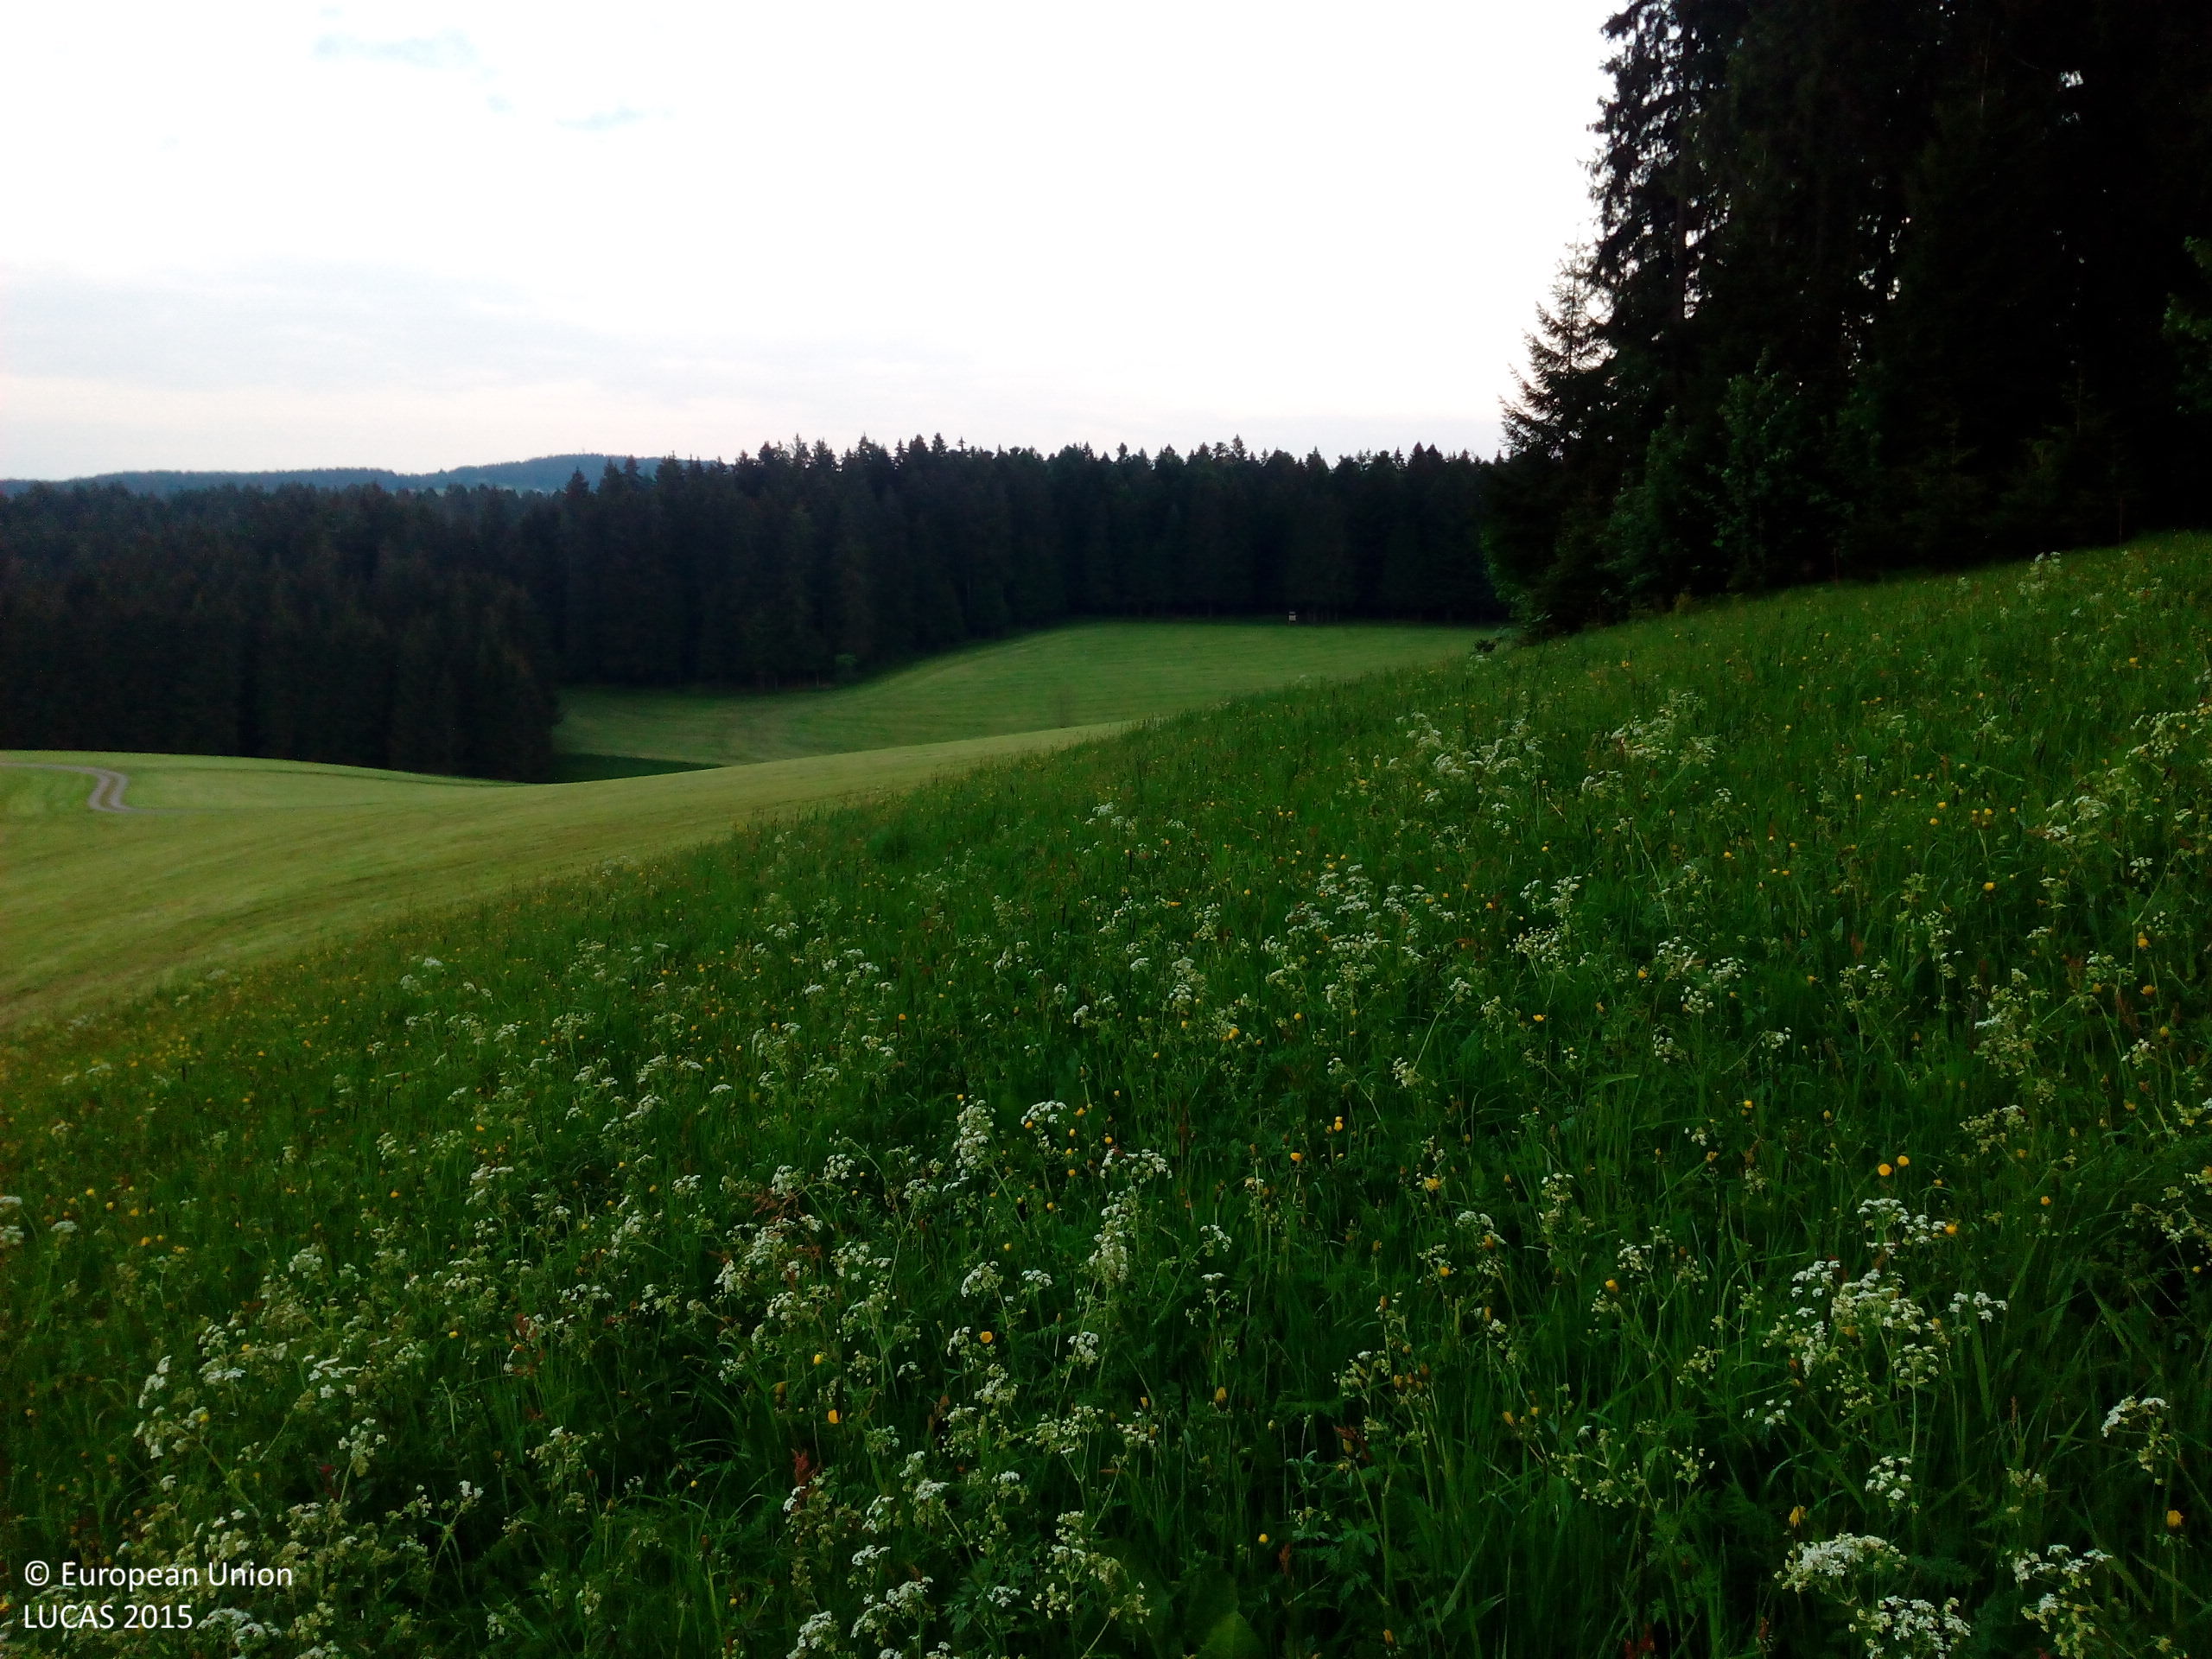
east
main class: Grassland
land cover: Grassland without tree/shrub cover
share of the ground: > 75 %
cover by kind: herbaceous plants 100 %
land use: Agriculture (excluding fallow land and kitchen gardens)
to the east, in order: Grassland without tree/shrub cover; Tracks; Grassland without tree/shrub cover; Tracks; Grassland without tree/shrub cover
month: May
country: DE
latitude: 48.0278
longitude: 8.1371
